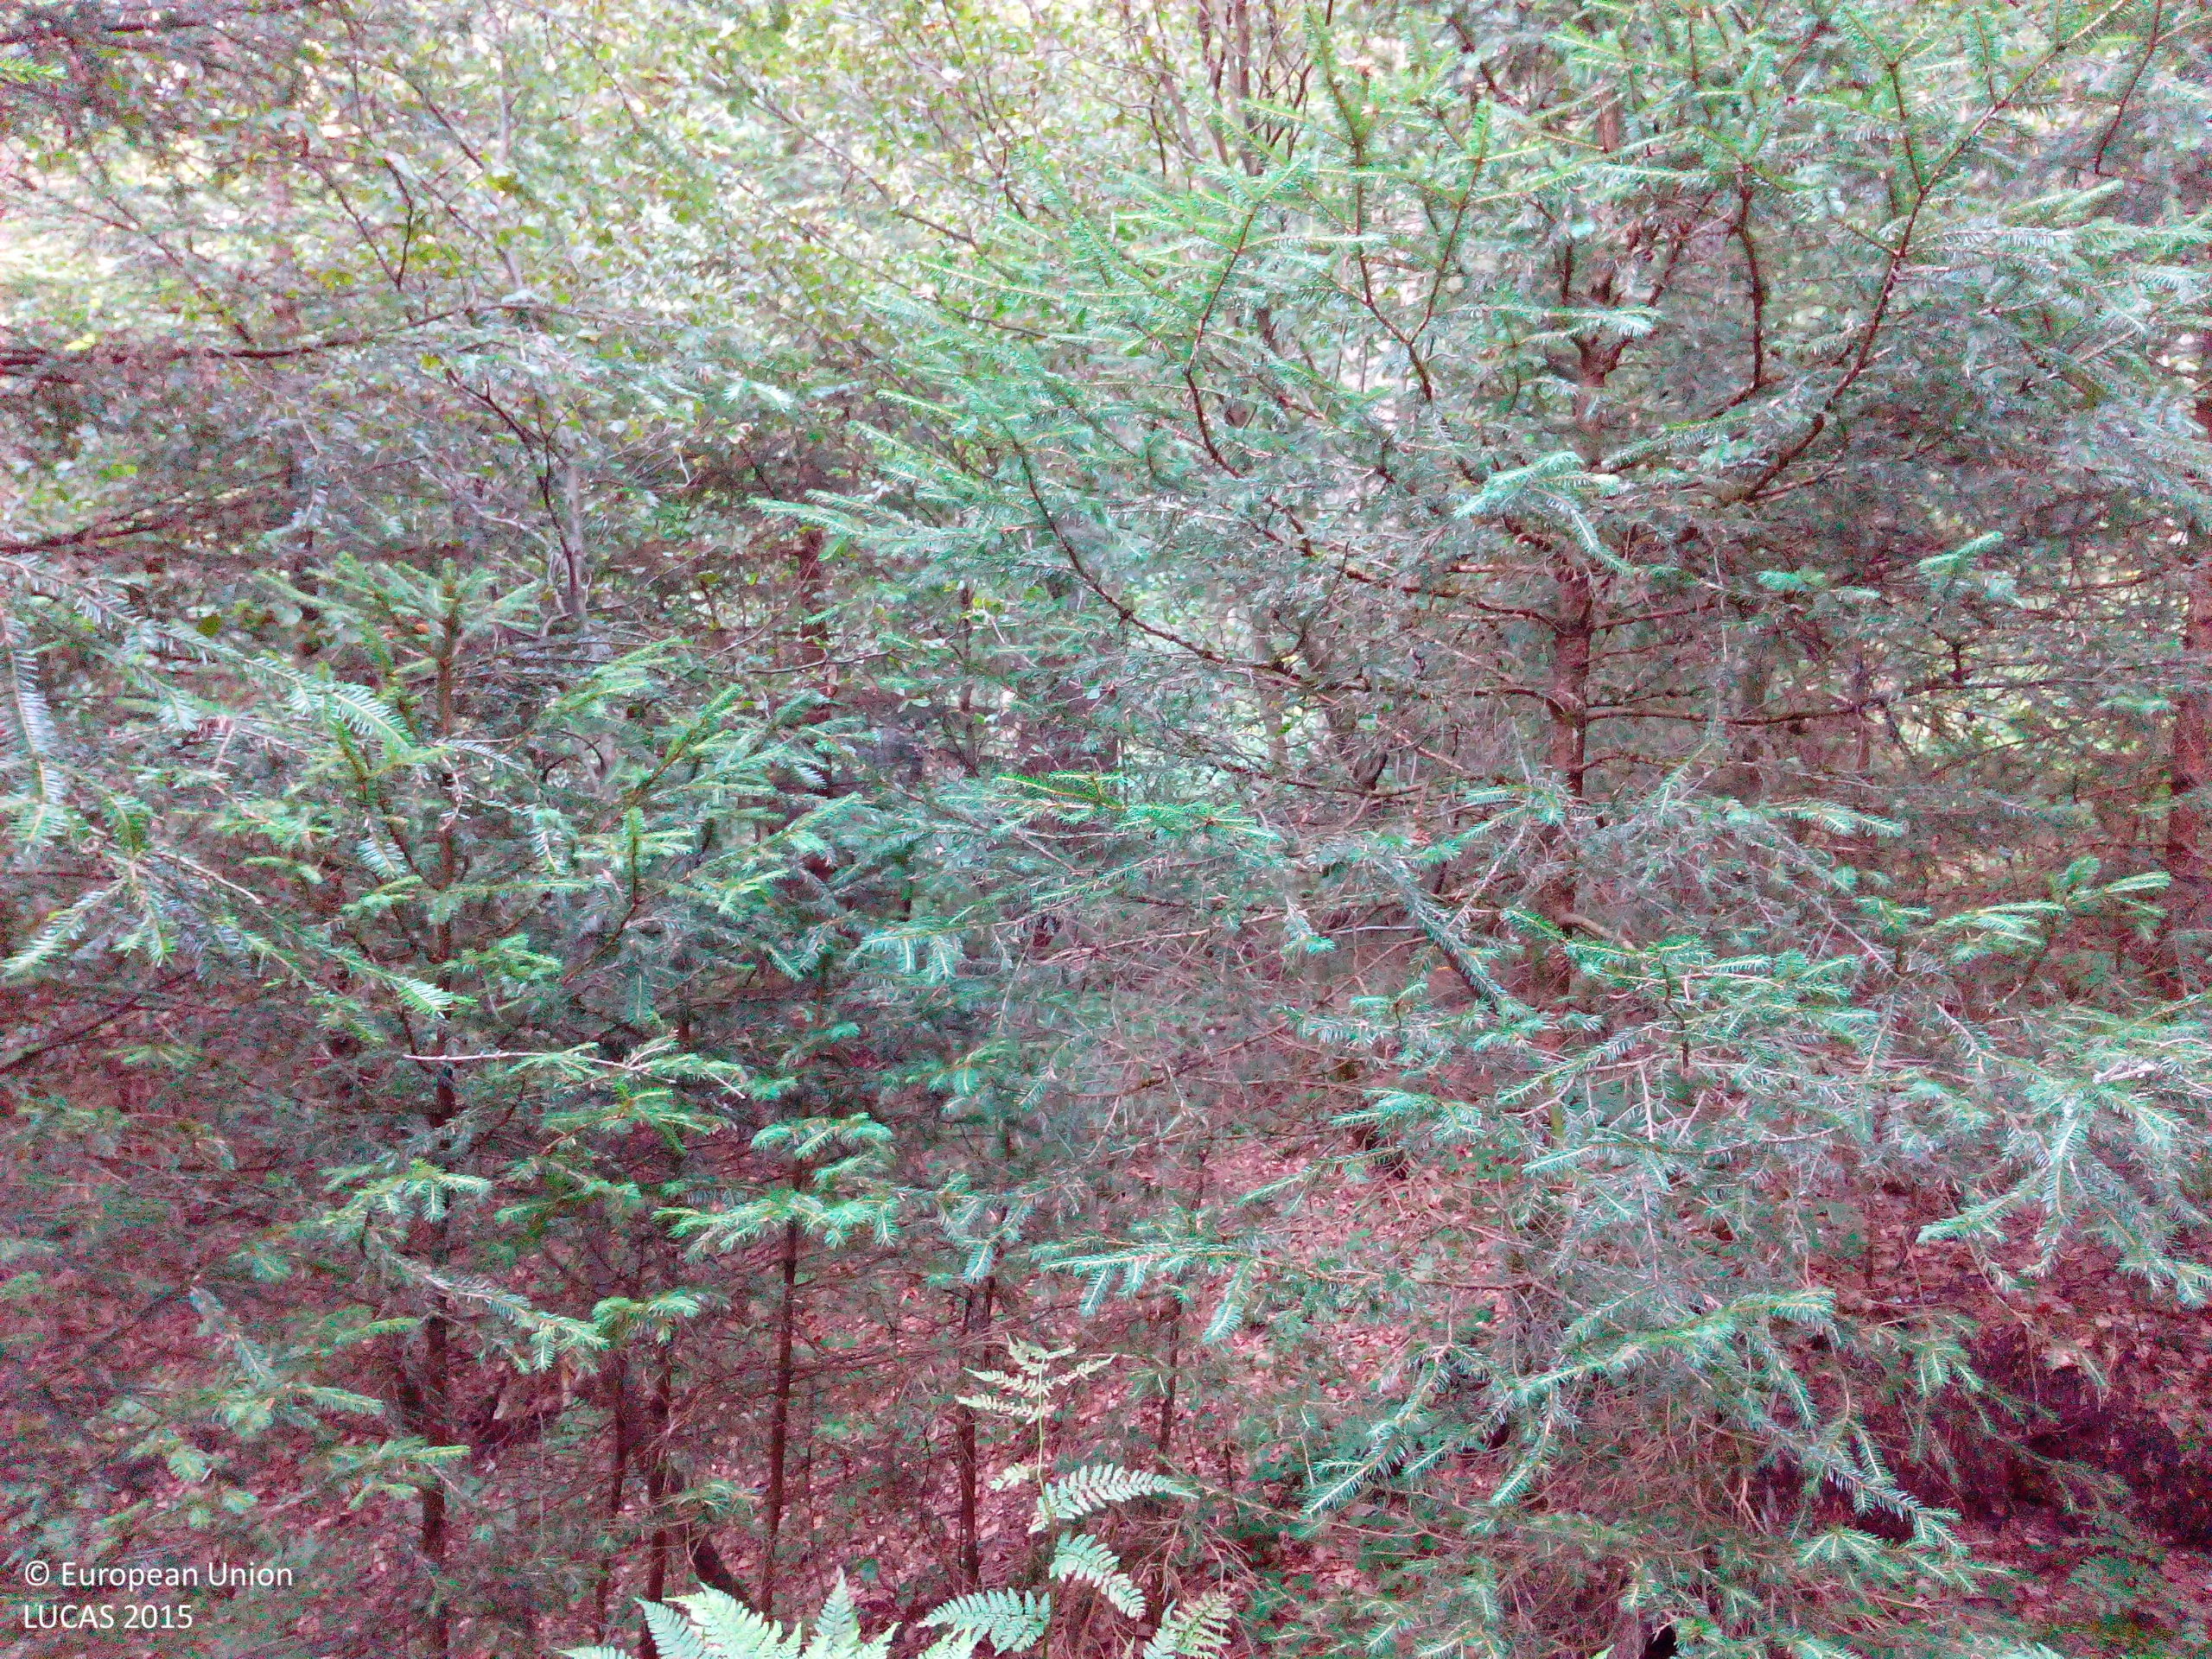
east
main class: Woodland
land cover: Other mixed woodland
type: beech forest
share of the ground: > 75 %
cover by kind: coniferous forest trees 50 %, broadleaved forest trees 35 %, herbaceous plants 5 %, lichens and mosses 5 %, unconsolidated bare surface 5 %
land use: Forestry
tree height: > 5 m
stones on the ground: < 10 %
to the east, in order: Other mixed woodland; Other coniferous woodland; Spruce dominated coniferous woodland; Tracks; Spruce dominated coniferous woodland; Tracks; Spruce dominated coniferous woodland
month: August
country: DE
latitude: 47.9028
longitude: 8.1952
